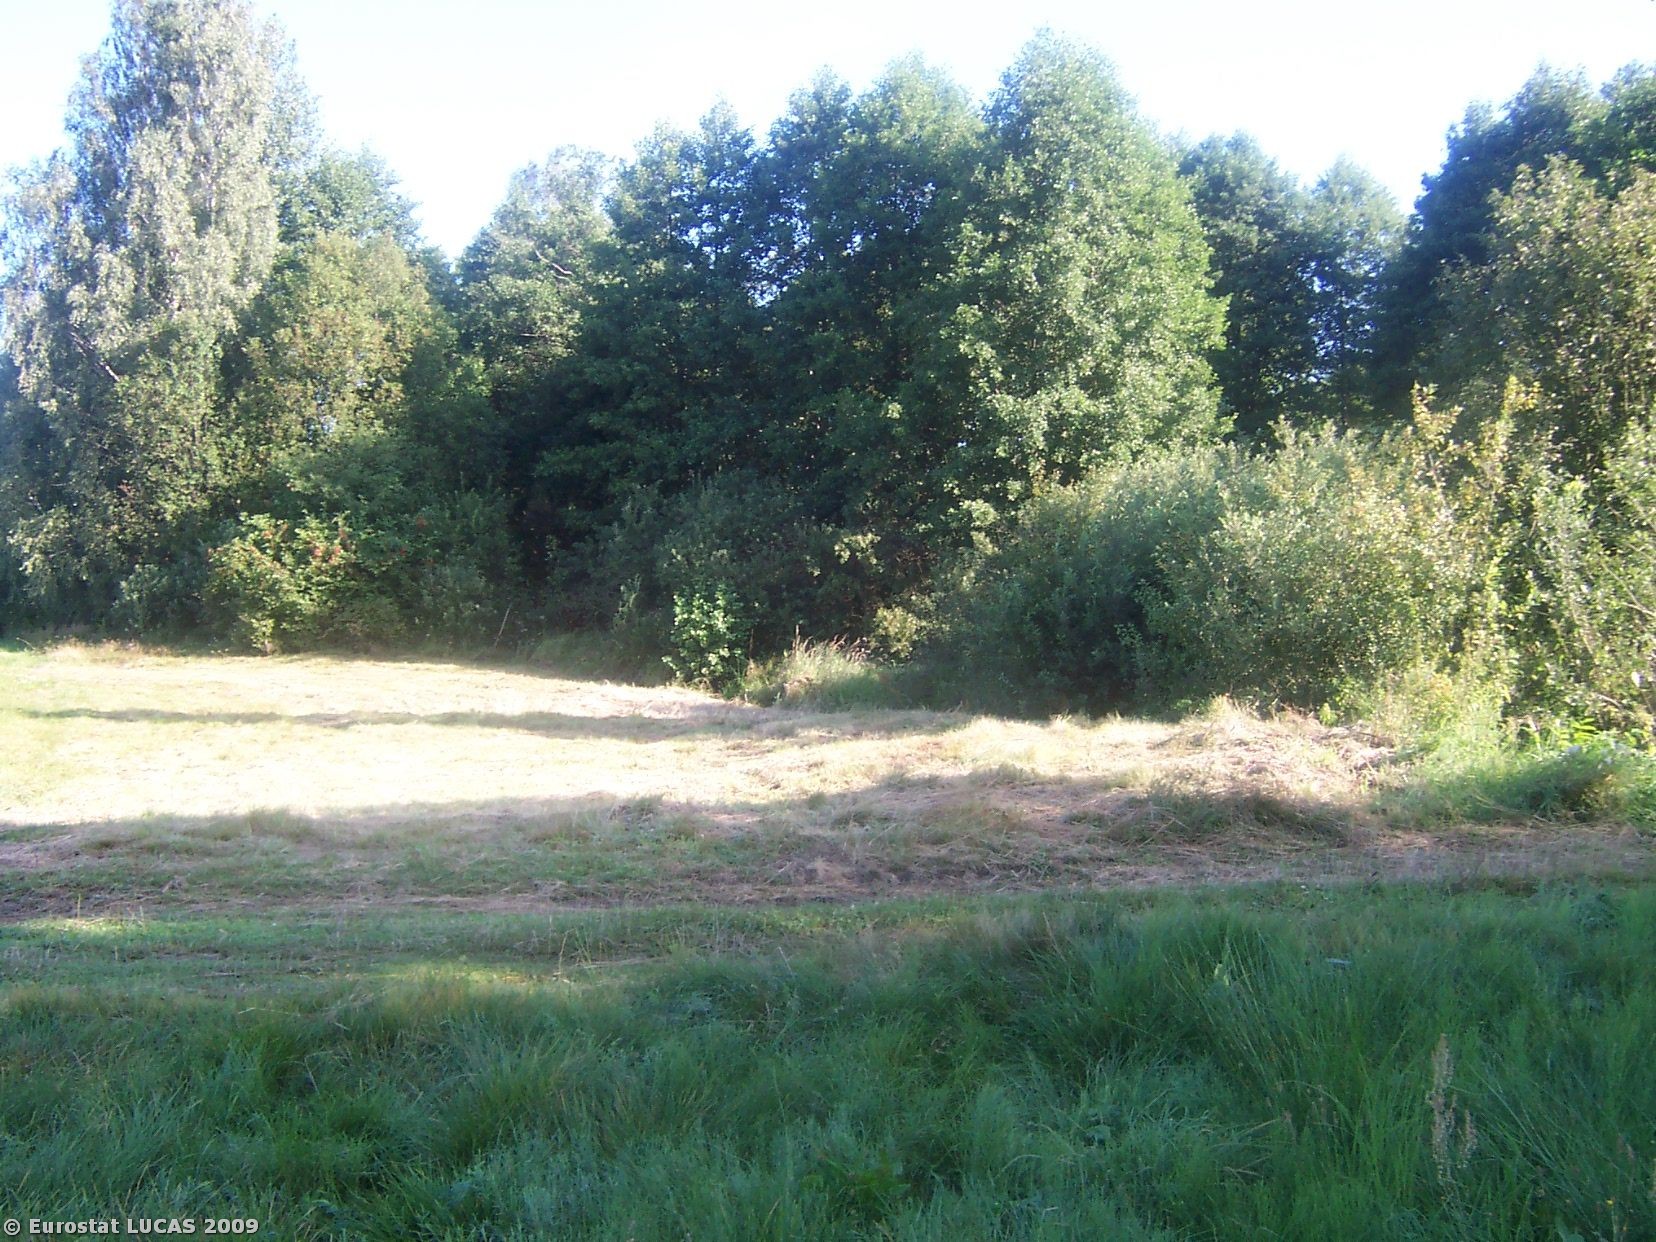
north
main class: Grassland
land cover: Grassland without tree/shrub cover
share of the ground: > 75 %
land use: Agriculture (excluding fallow land and kitchen gardens)
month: August
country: PL
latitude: 52.6522
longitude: 21.1173
